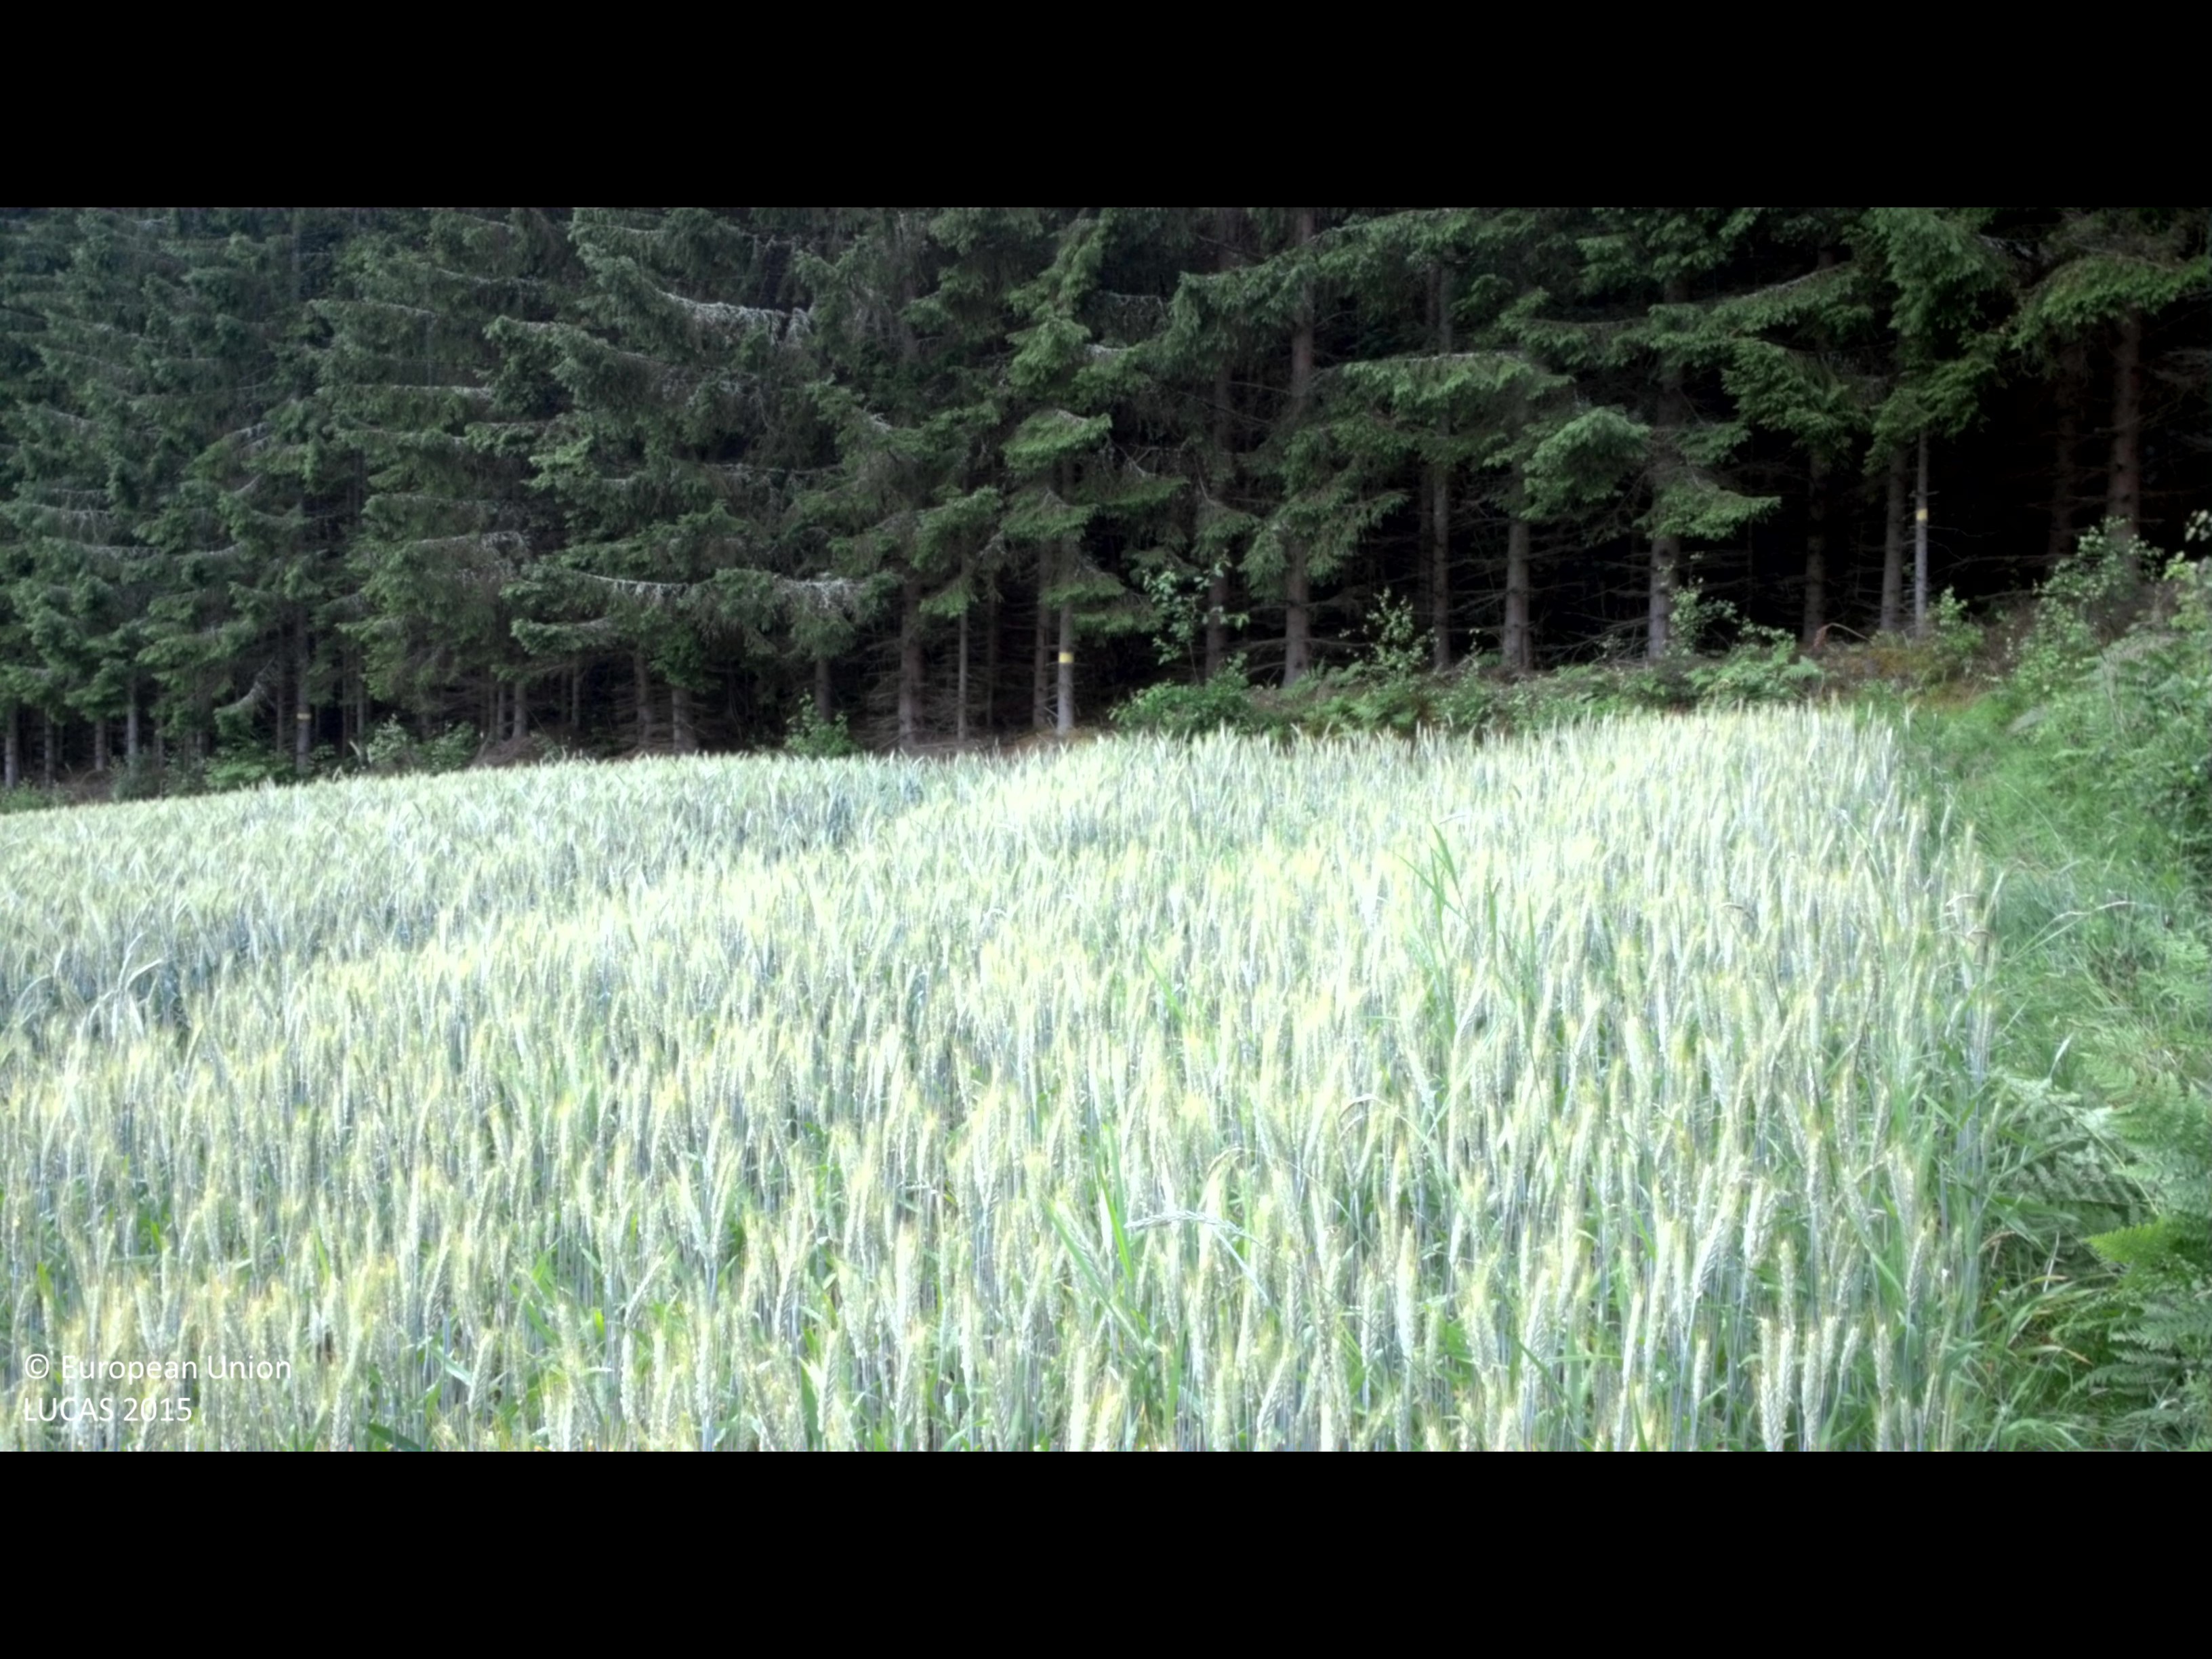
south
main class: Cropland
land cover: Rye
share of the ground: > 75 %
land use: Agriculture (excluding fallow land and kitchen gardens)
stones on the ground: < 10 %
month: July
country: SE
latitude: 58.3457
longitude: 16.2317
